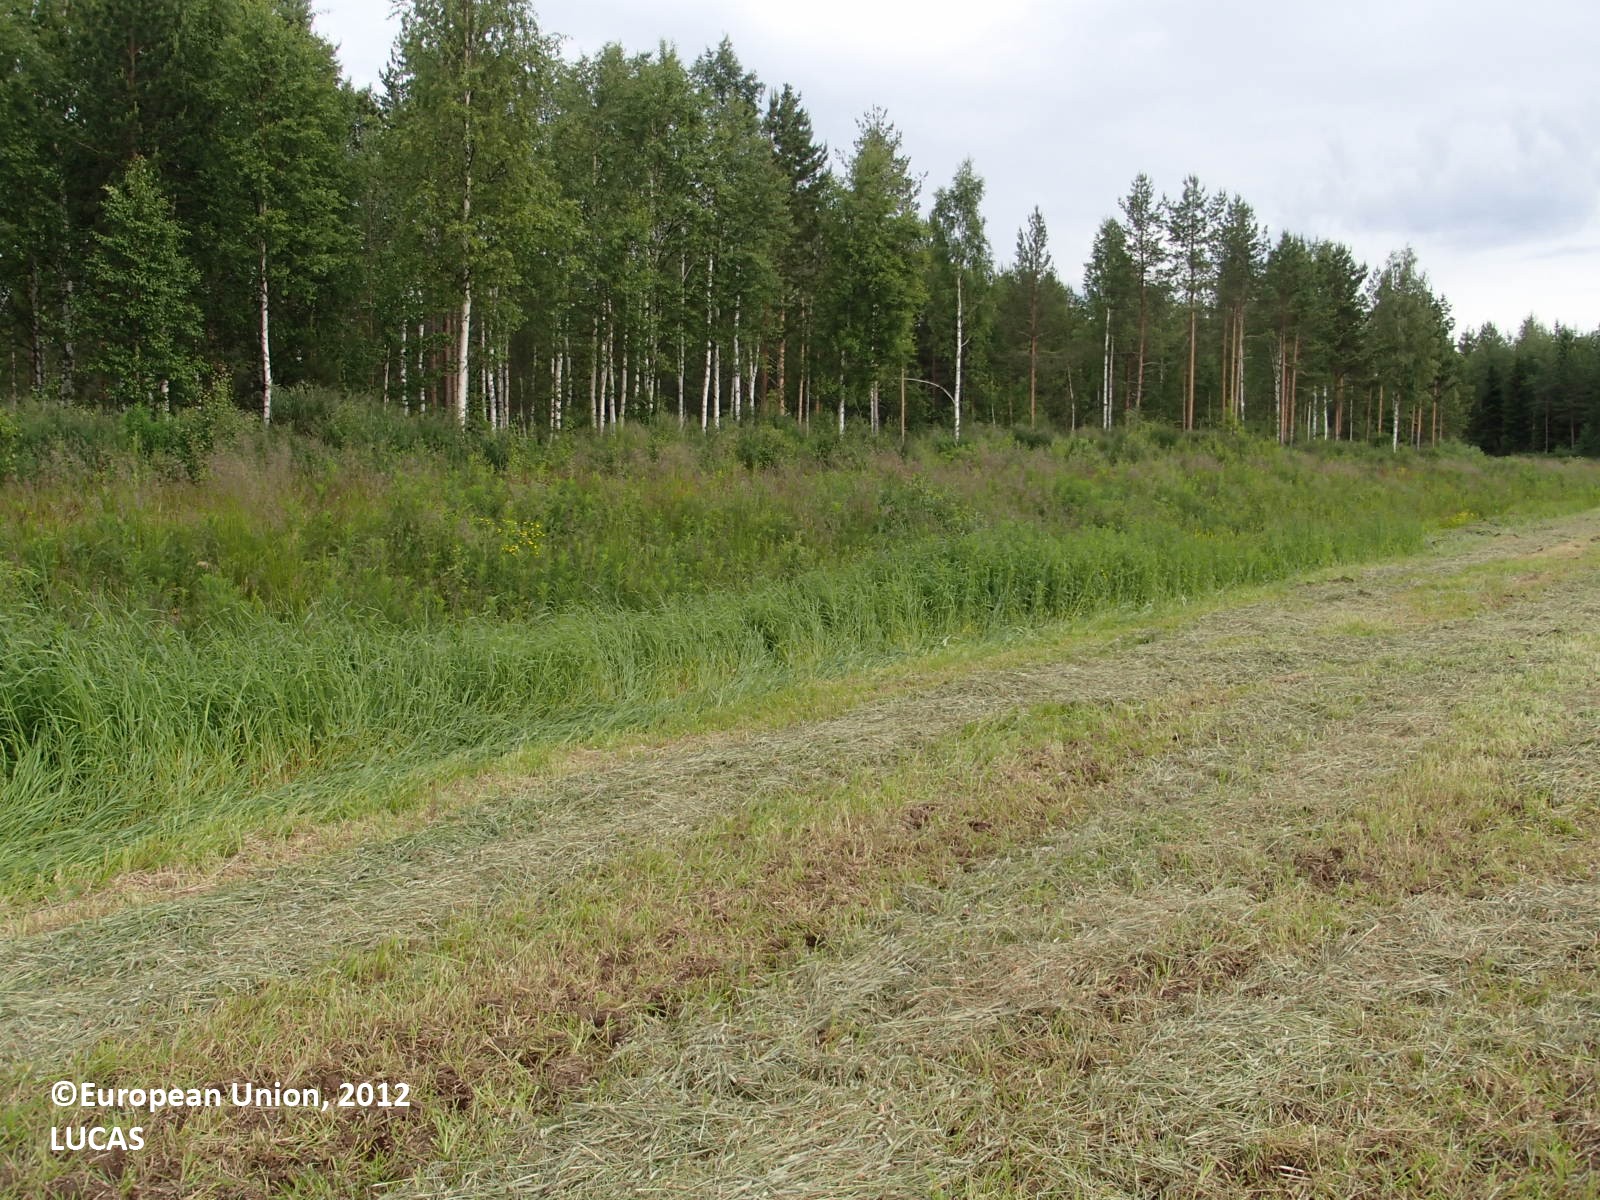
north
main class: Cropland
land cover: Temporary grasslands
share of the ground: > 75 %
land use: Agriculture (excluding fallow land and kitchen gardens)
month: July
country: FI
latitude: 64.1385
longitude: 27.0025
